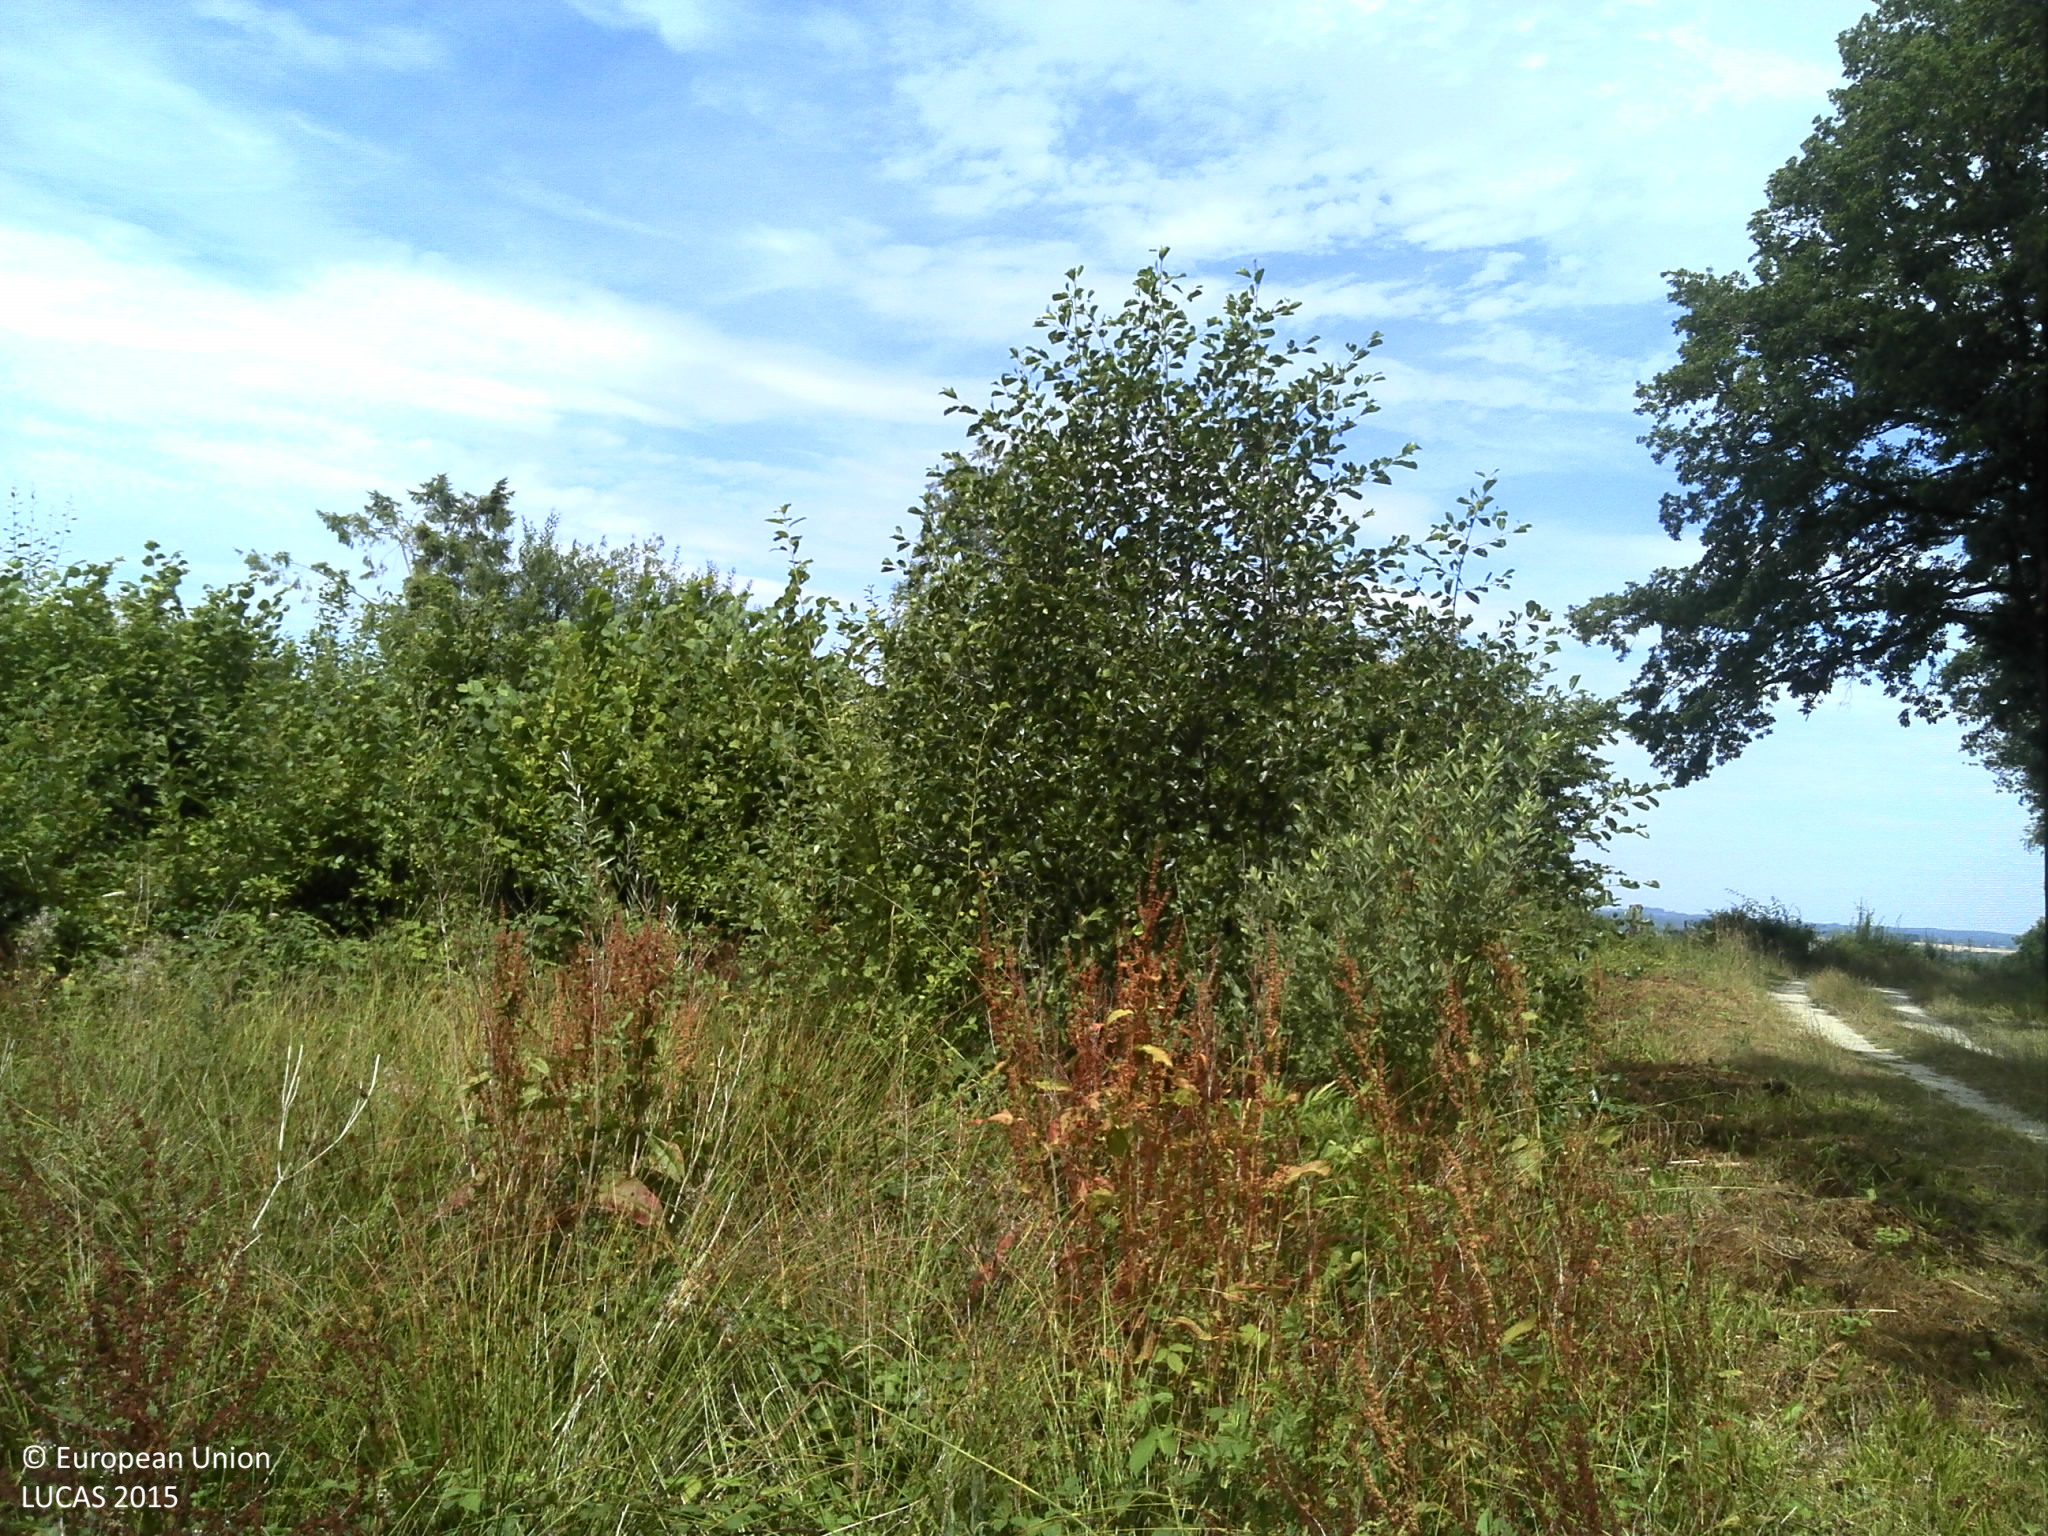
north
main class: Woodland
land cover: Broadleaved woodland
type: non-riverine alder, birch or aspen forest
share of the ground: > 75 %
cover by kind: broadleaved forest trees 50 %, herbaceous plants 50 %
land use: Forestry
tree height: < 5 m
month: July
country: FR
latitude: 49.6245
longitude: 4.2505
